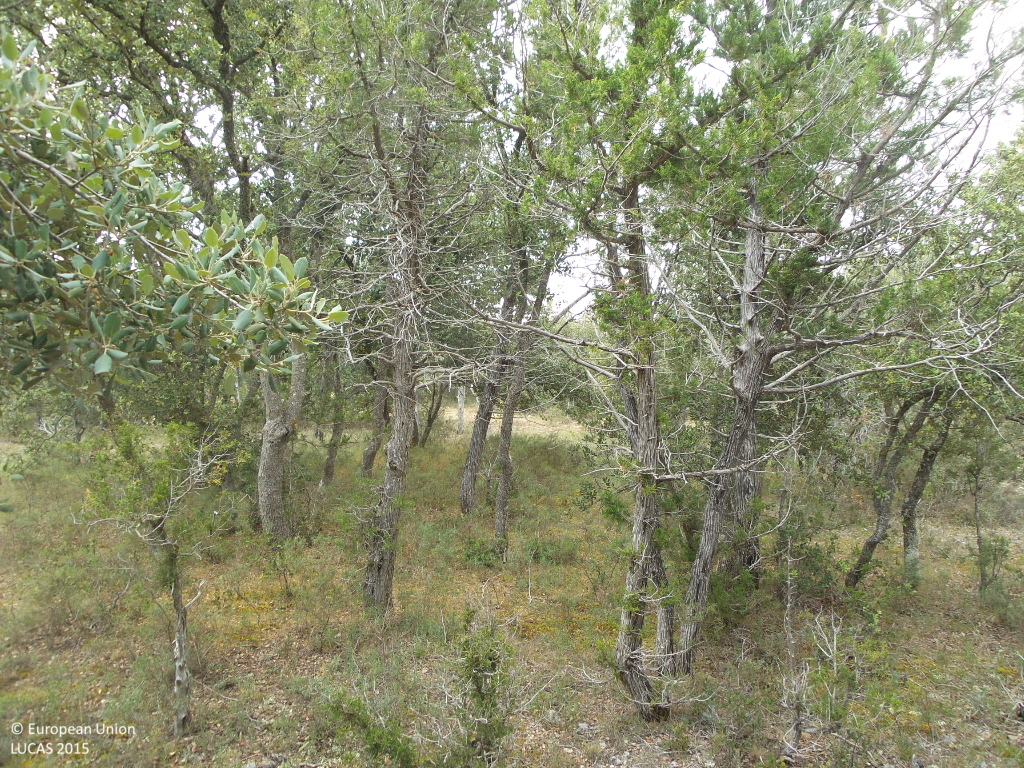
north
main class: Woodland
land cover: Other mixed woodland
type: broadleaved evergreen forest
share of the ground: 50 - 75 %
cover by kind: broadleaved forest trees 40 %, coniferous forest trees 30 %, shrubs 20 %, herbaceous plants 5 %, lichens and mosses 5 %
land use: Semi-natural and natural areas not in use
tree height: > 5 m
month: June
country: ES
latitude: 41.4569
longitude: -3.2003
